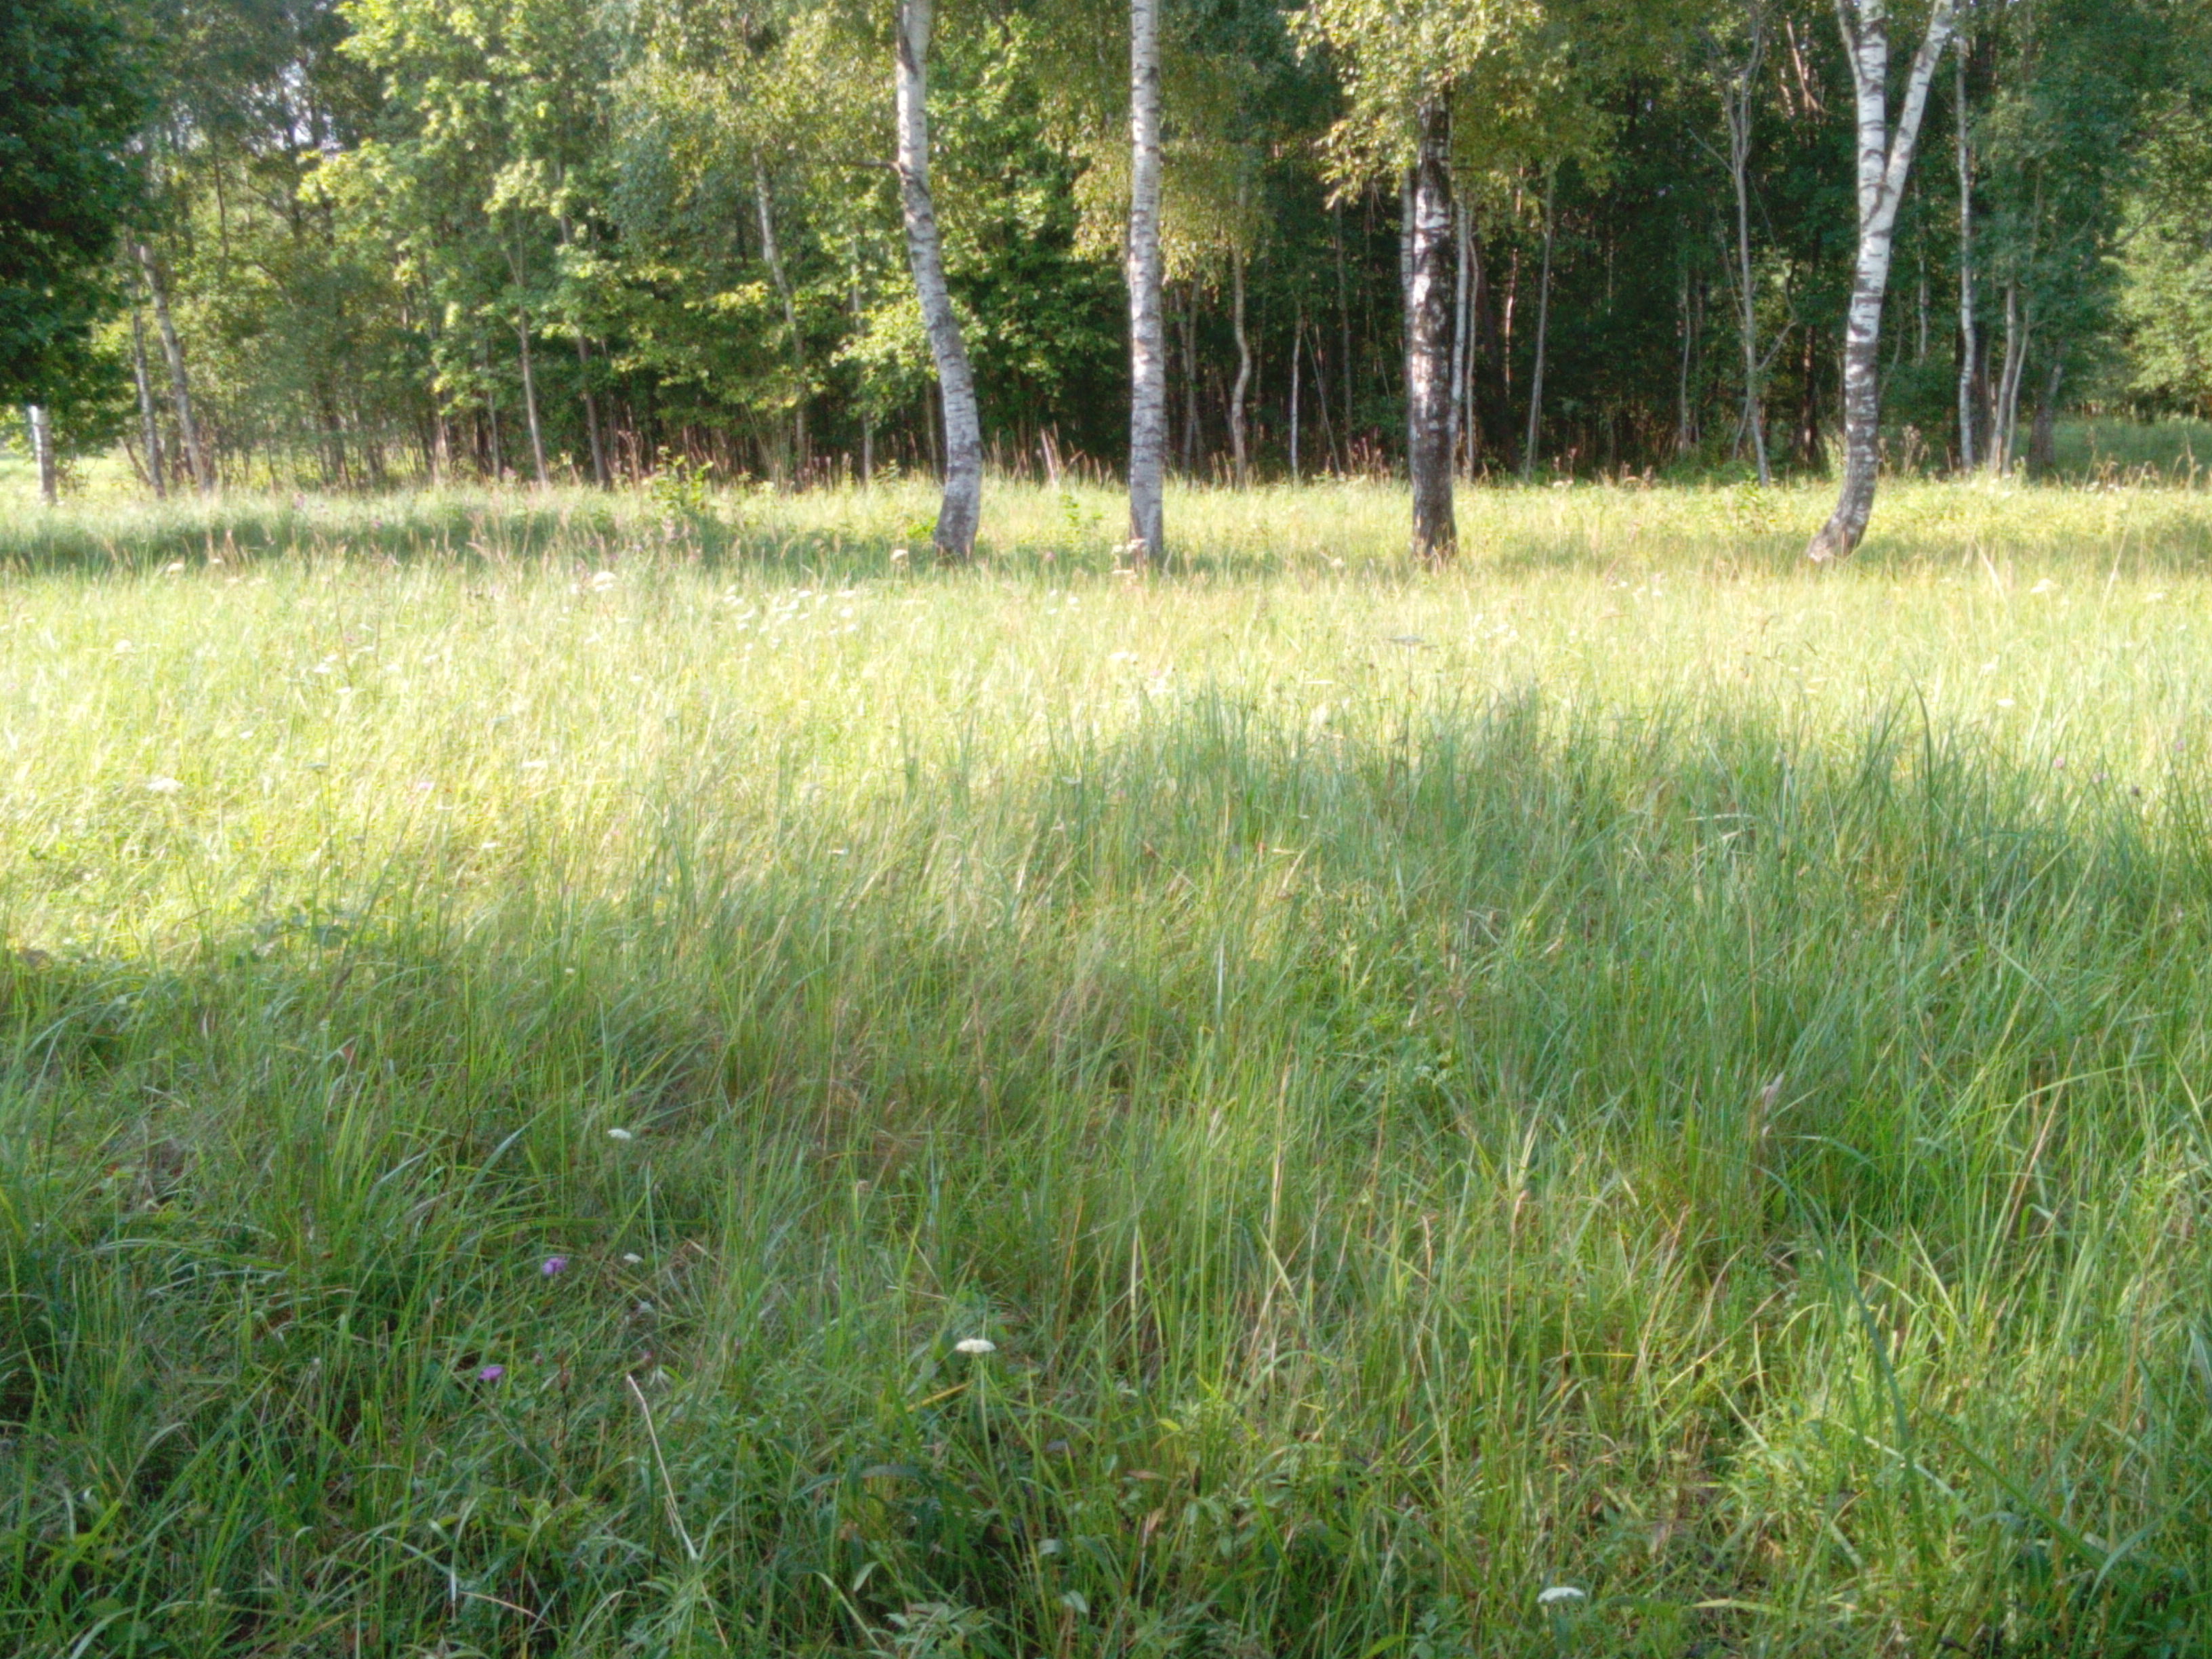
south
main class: Woodland
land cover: Broadleaved woodland
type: non-riverine alder, birch or aspen forest
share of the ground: 25 - 50 %
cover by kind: herbaceous plants 60 %, broadleaved forest trees 40 %
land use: Forestry
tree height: > 5 m
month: August
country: LV
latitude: 56.5776
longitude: 21.0897
